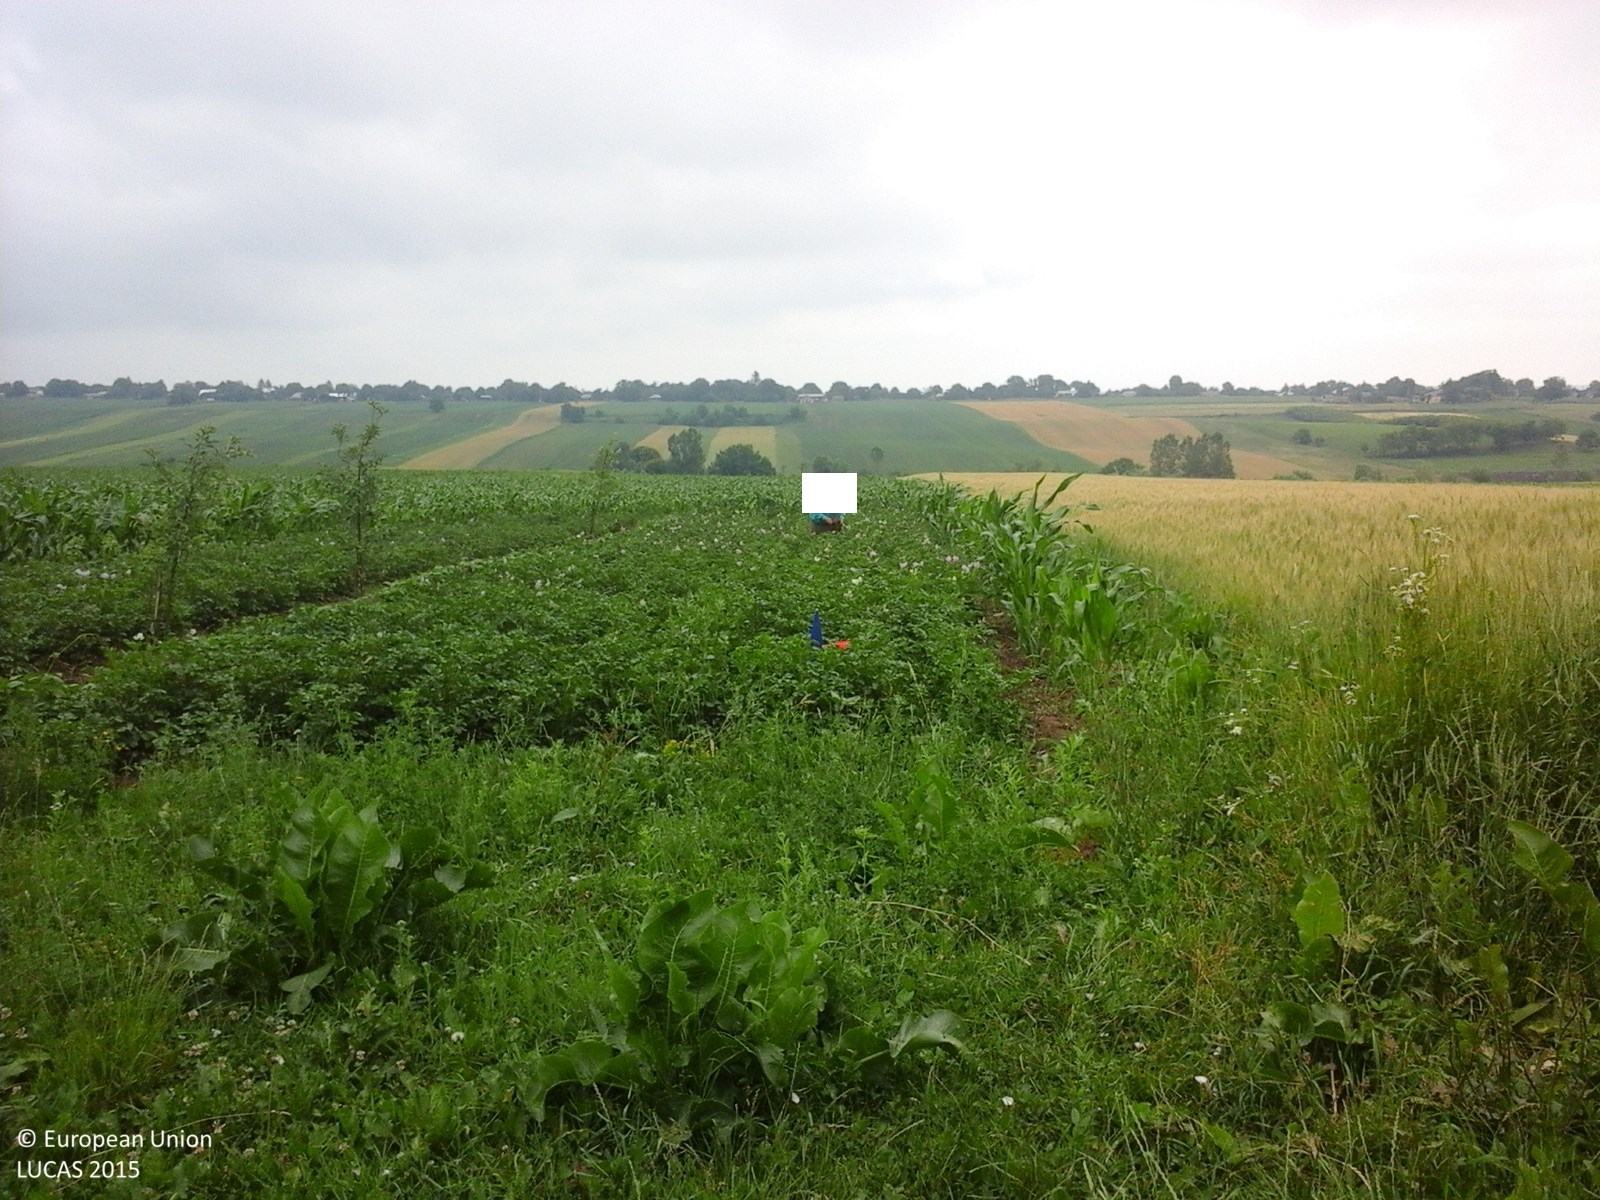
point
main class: Cropland
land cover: Potatoes
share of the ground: > 75 %
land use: Agriculture (excluding fallow land and kitchen gardens)
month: June
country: RO
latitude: 48.1206
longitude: 26.4124
